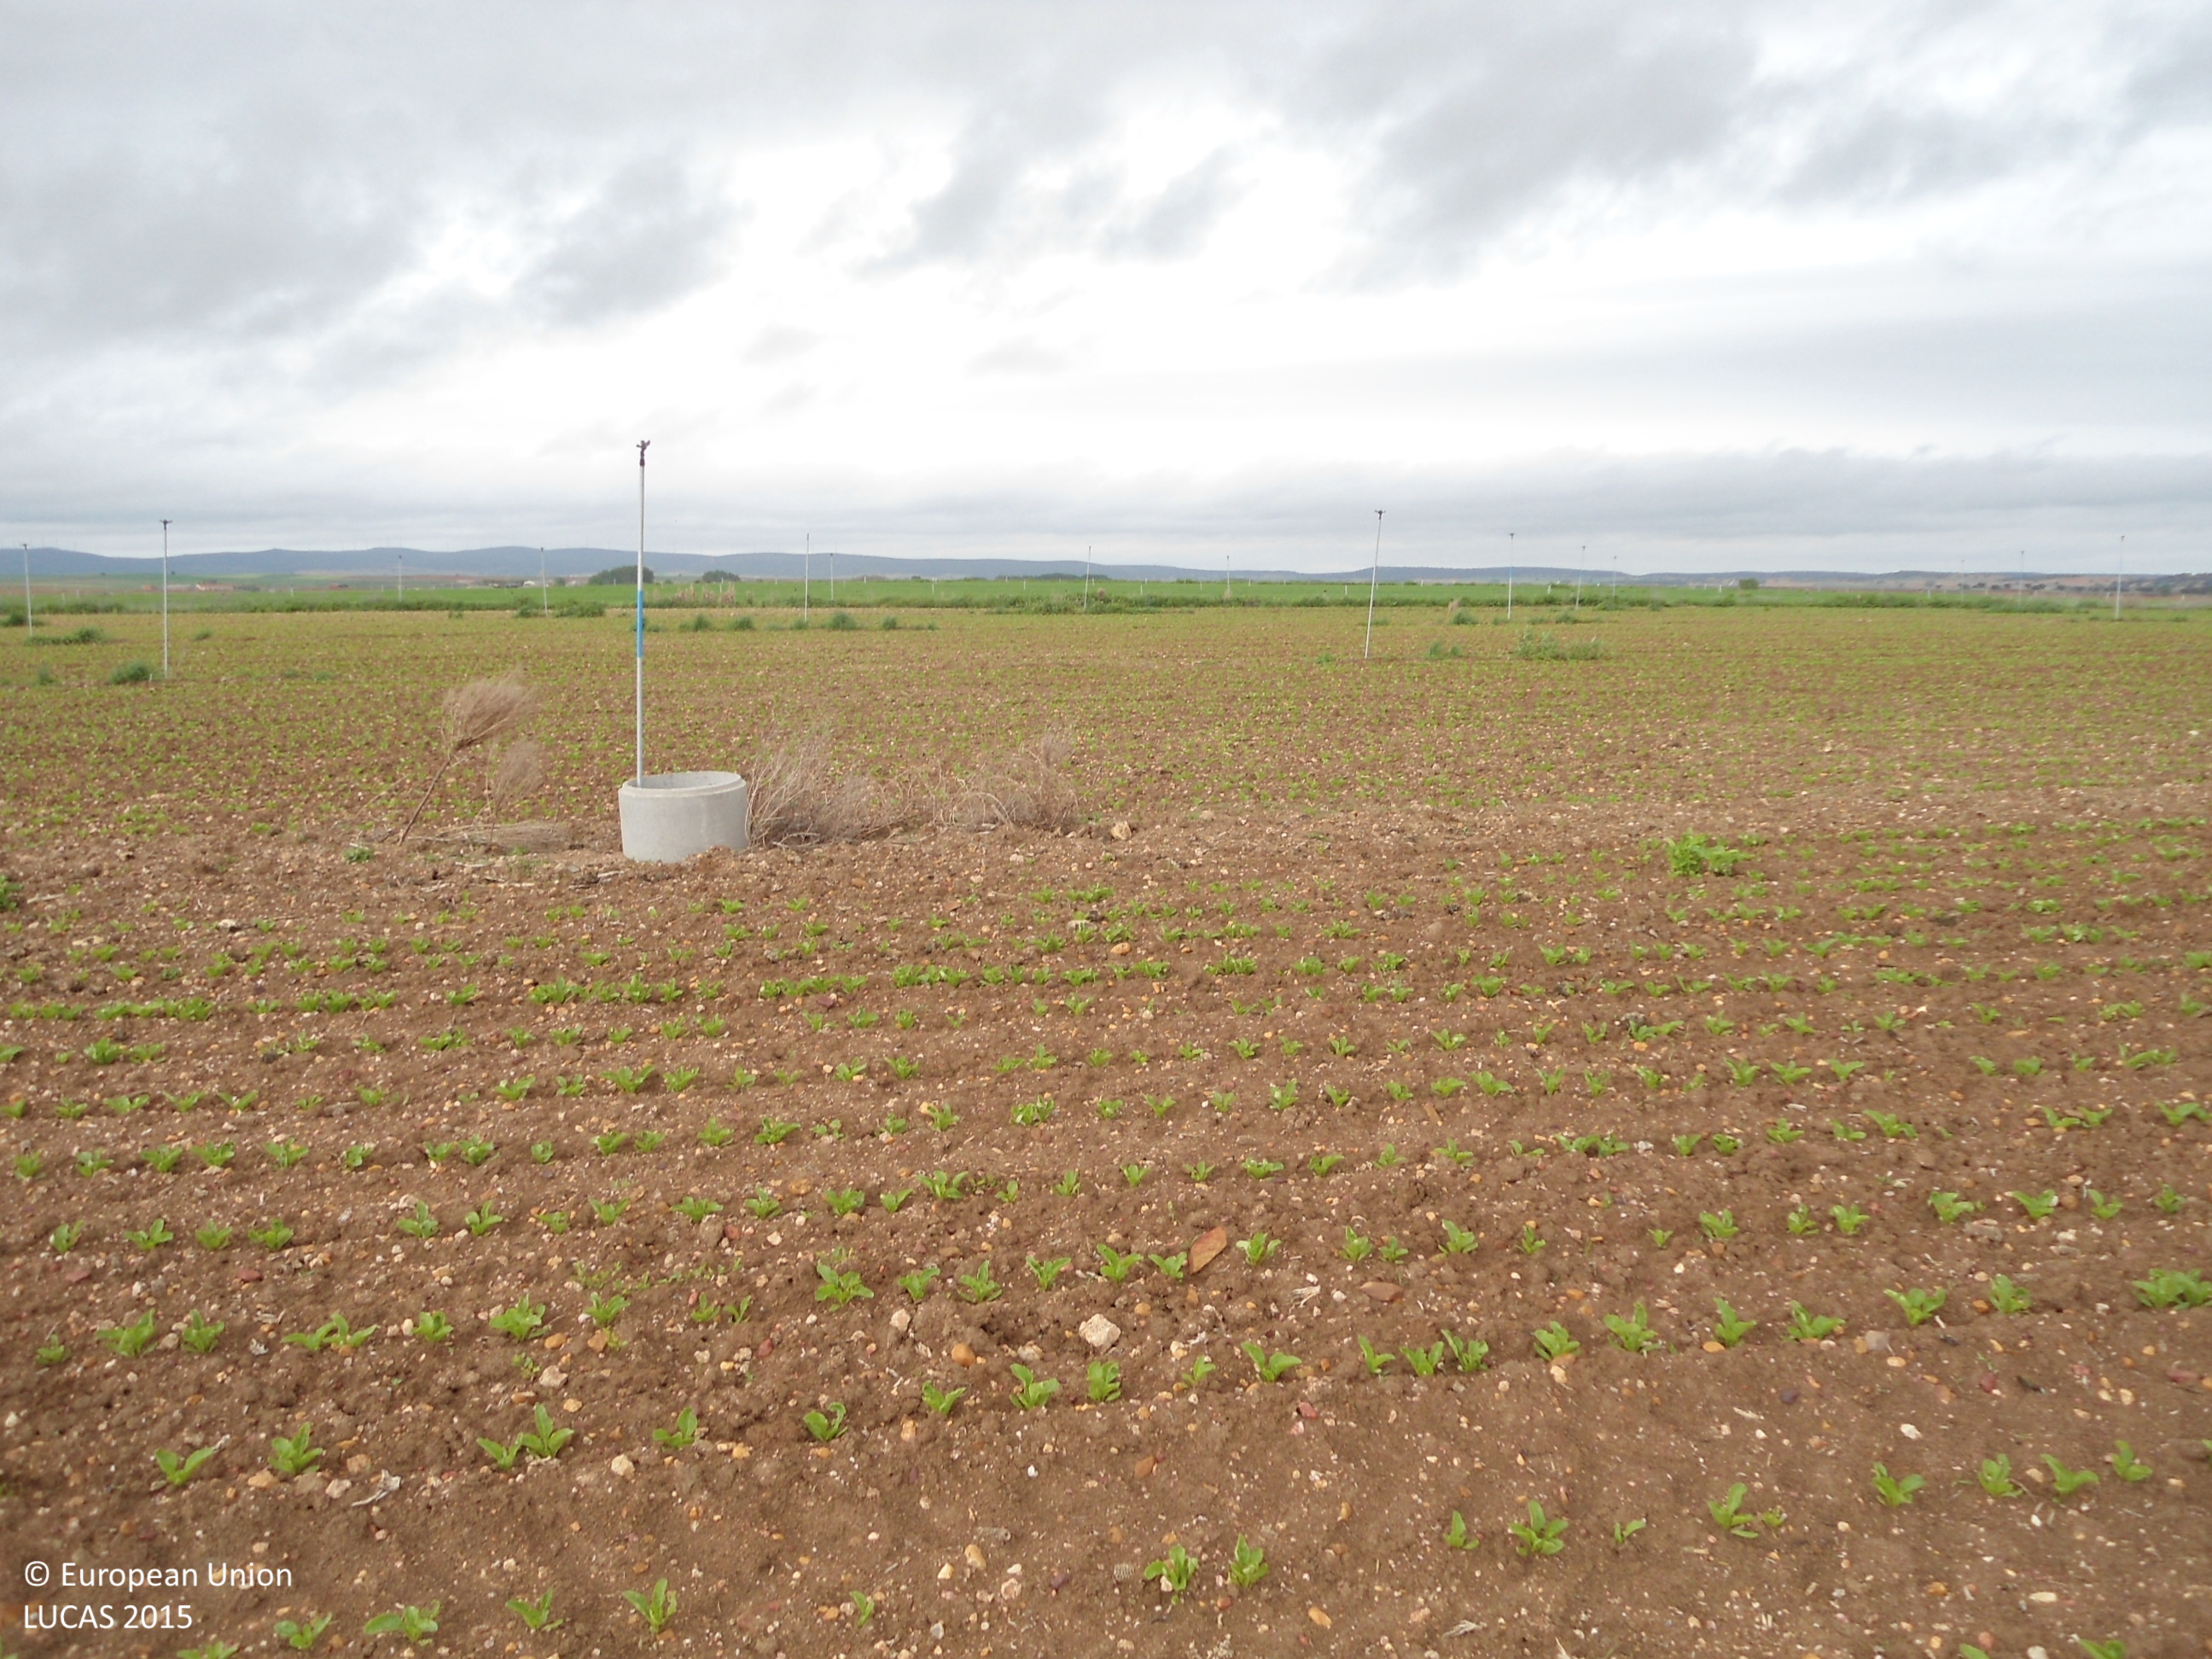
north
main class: Cropland
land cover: Sugar beet
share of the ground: 25 - 50 %
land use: Agriculture (excluding fallow land and kitchen gardens)
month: May
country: ES
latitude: 41.7800
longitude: -5.8660
